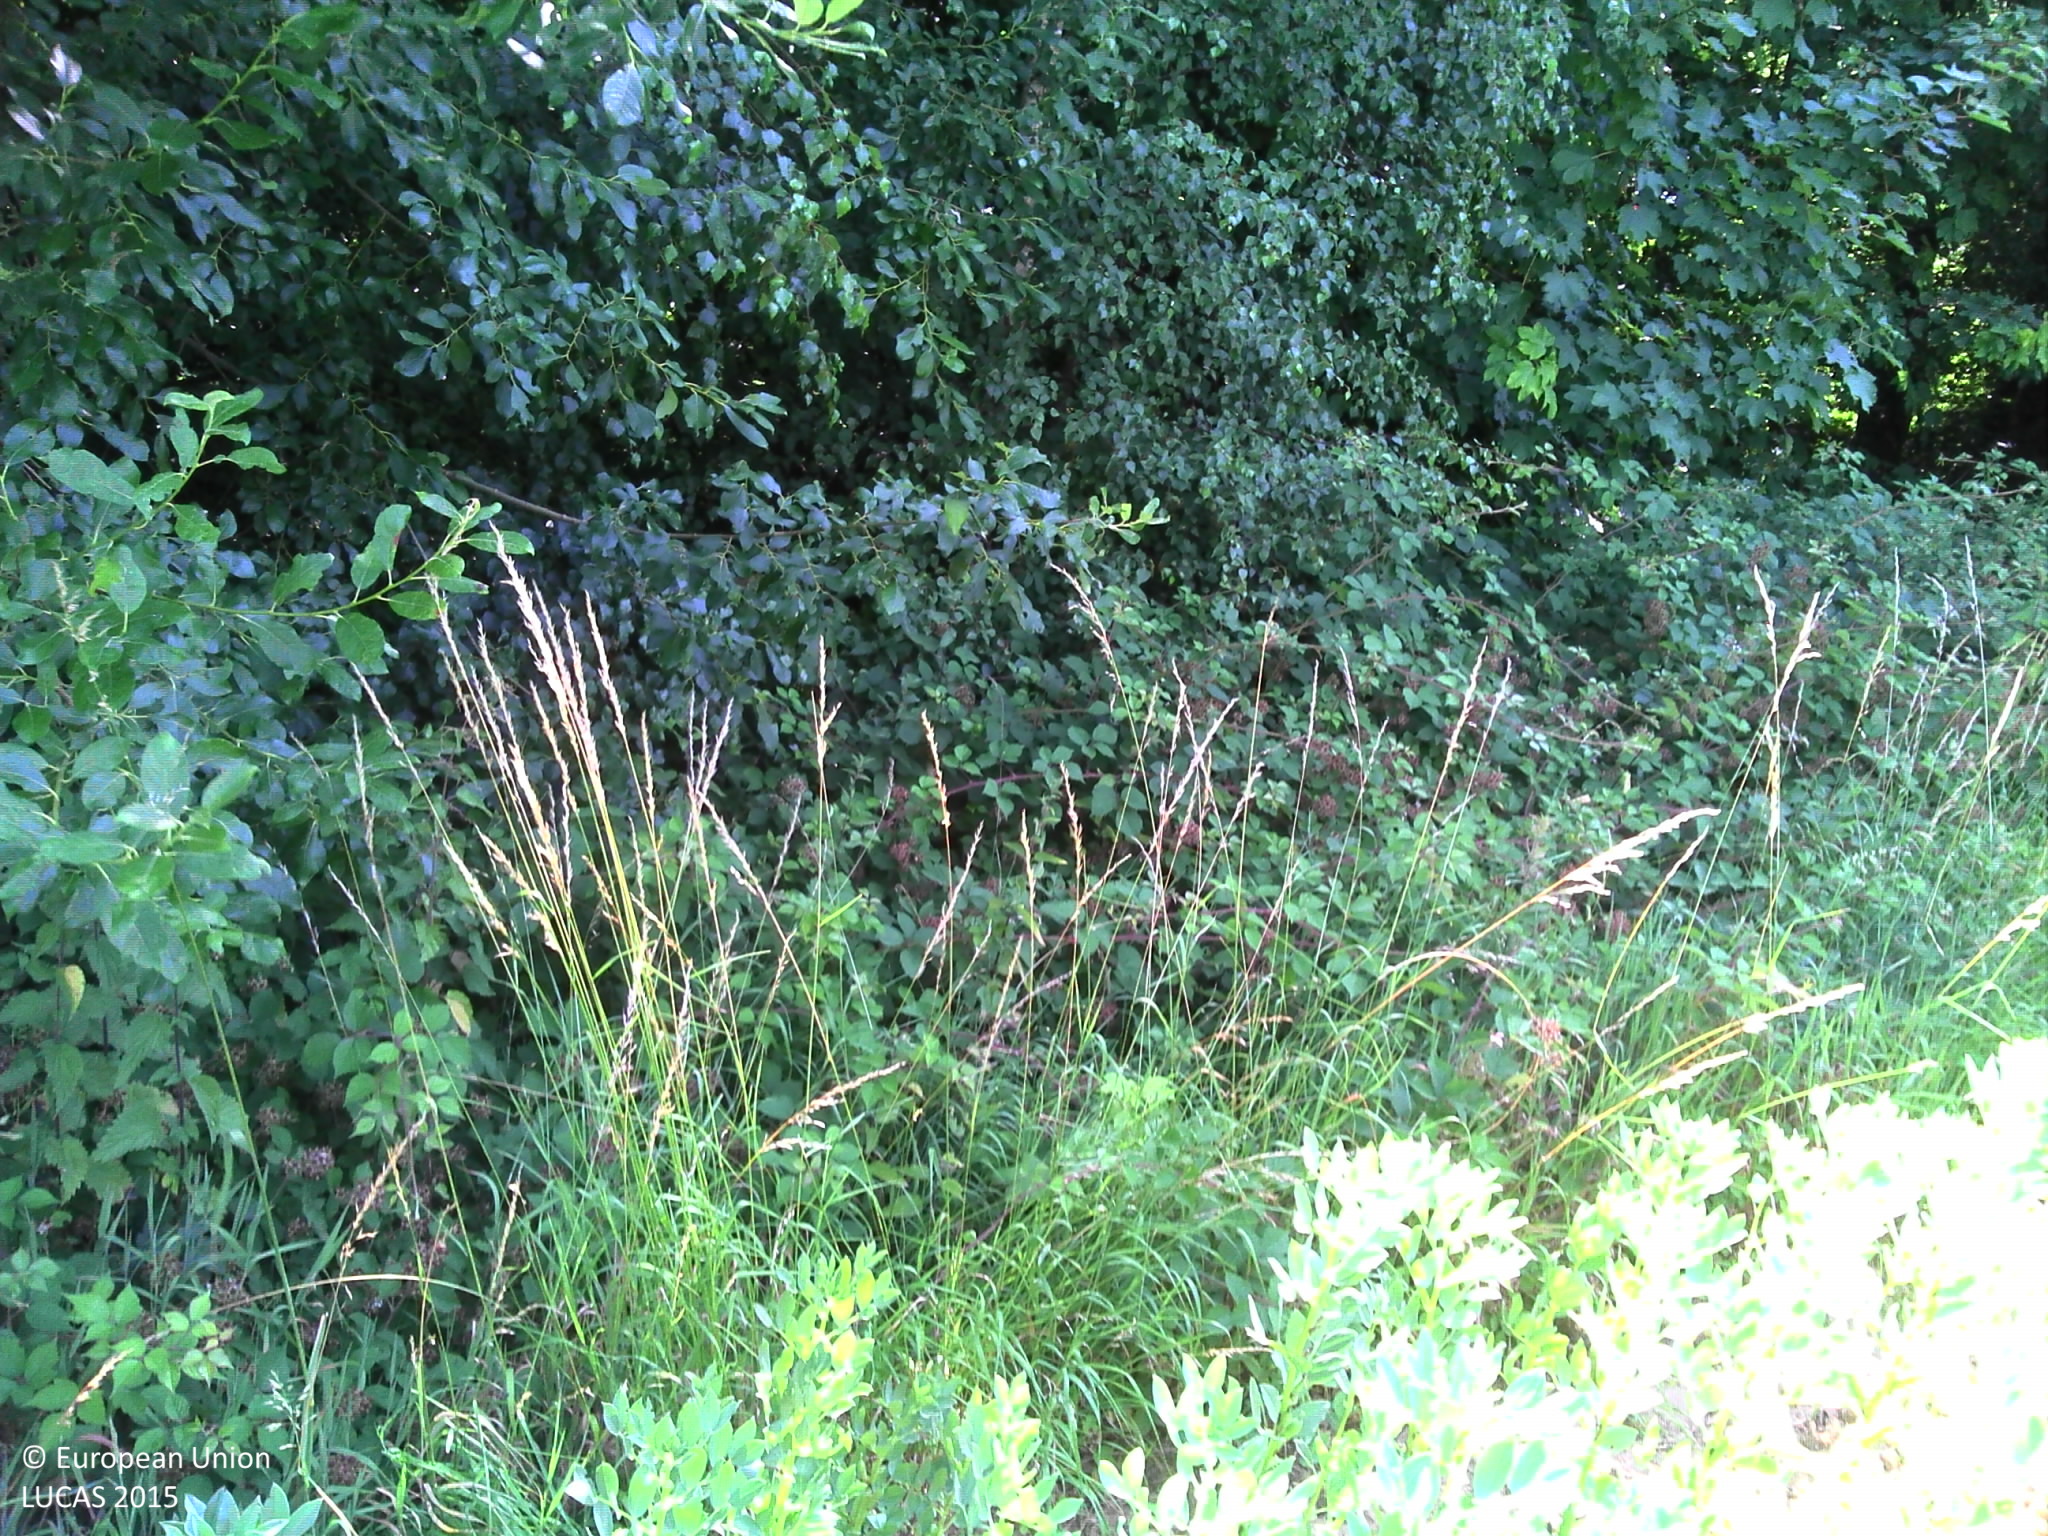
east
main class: Cropland
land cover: Dry pulses
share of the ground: > 75 %
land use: Agriculture (excluding fallow land and kitchen gardens)
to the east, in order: Dry pulses; Grass margins; Broadleaved woodland; Ditches and canals; Broadleaved woodland; Tracks; Broadleaved woodland; Tracks; Broadleaved woodland; Tracks; Broadleaved woodland
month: July
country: FR
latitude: 49.4623
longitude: 5.9014
